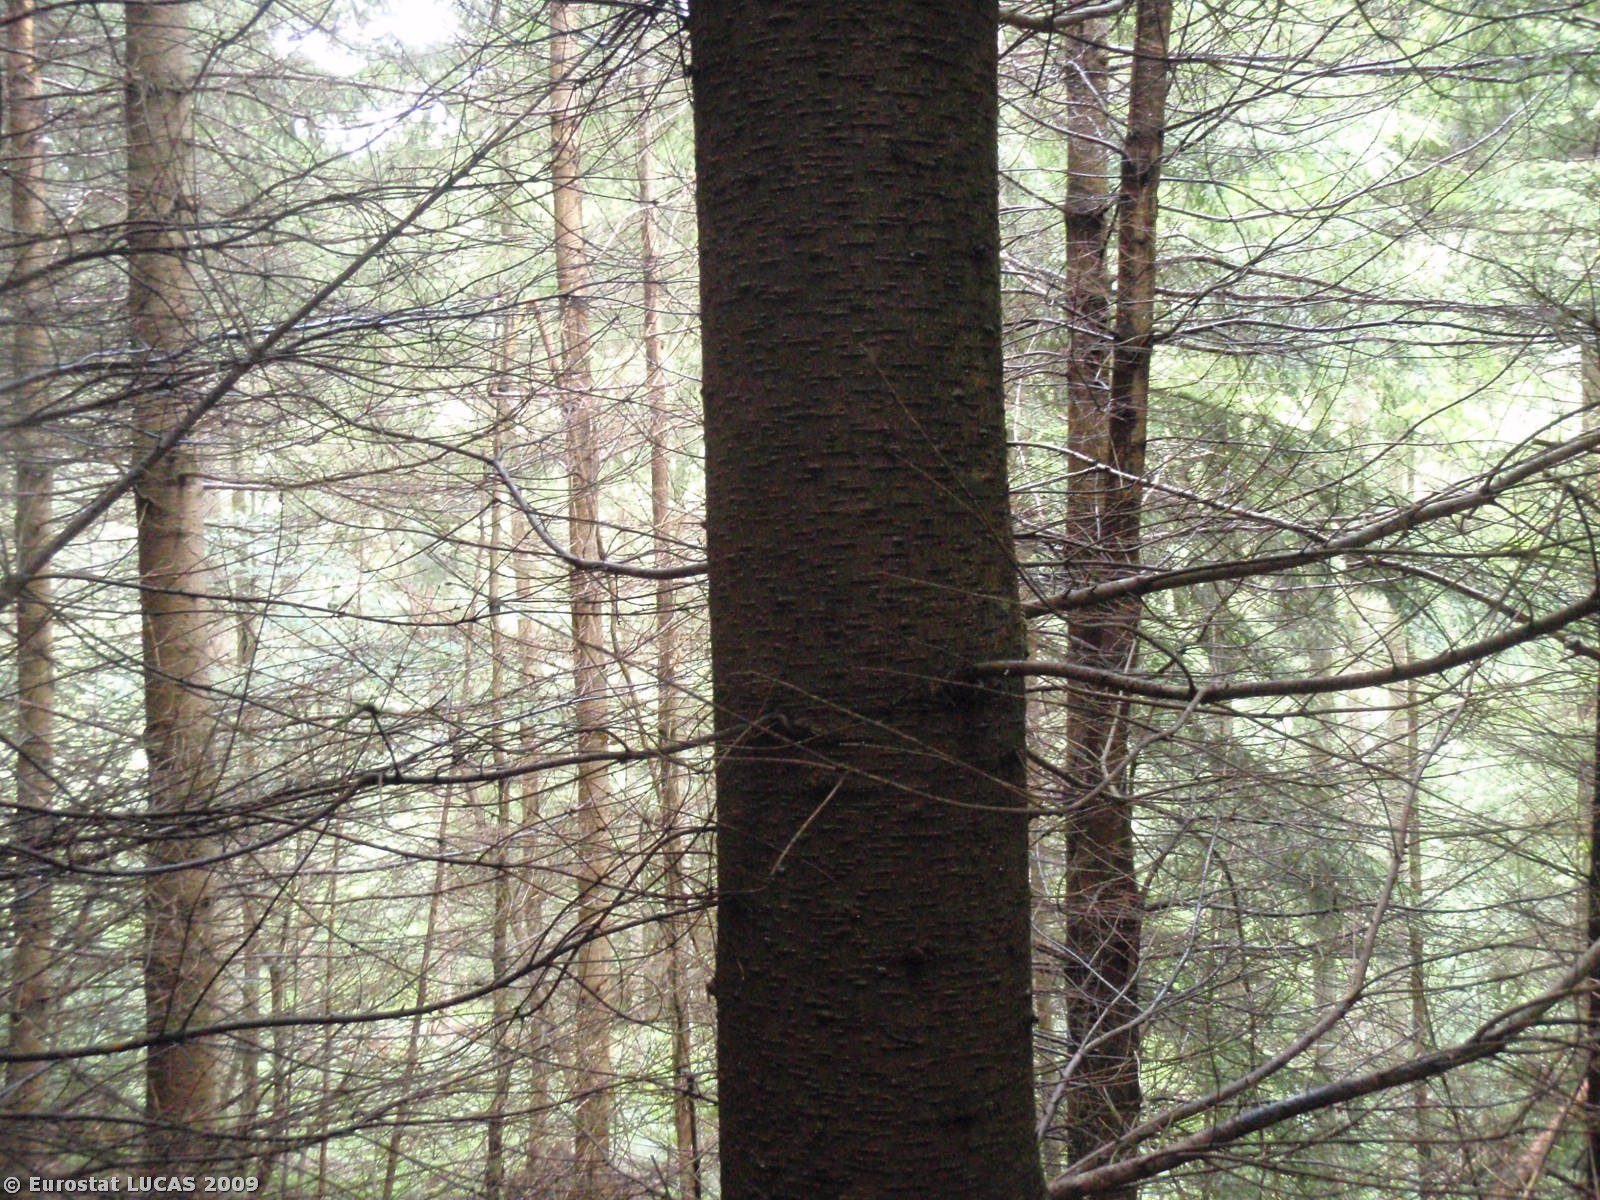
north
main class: Woodland
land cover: Coniferous woodland
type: plantations and self-sown exotic forest
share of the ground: > 75 %
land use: Forestry
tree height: > 5 m
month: August
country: GB
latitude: 51.1691
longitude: -3.4557
